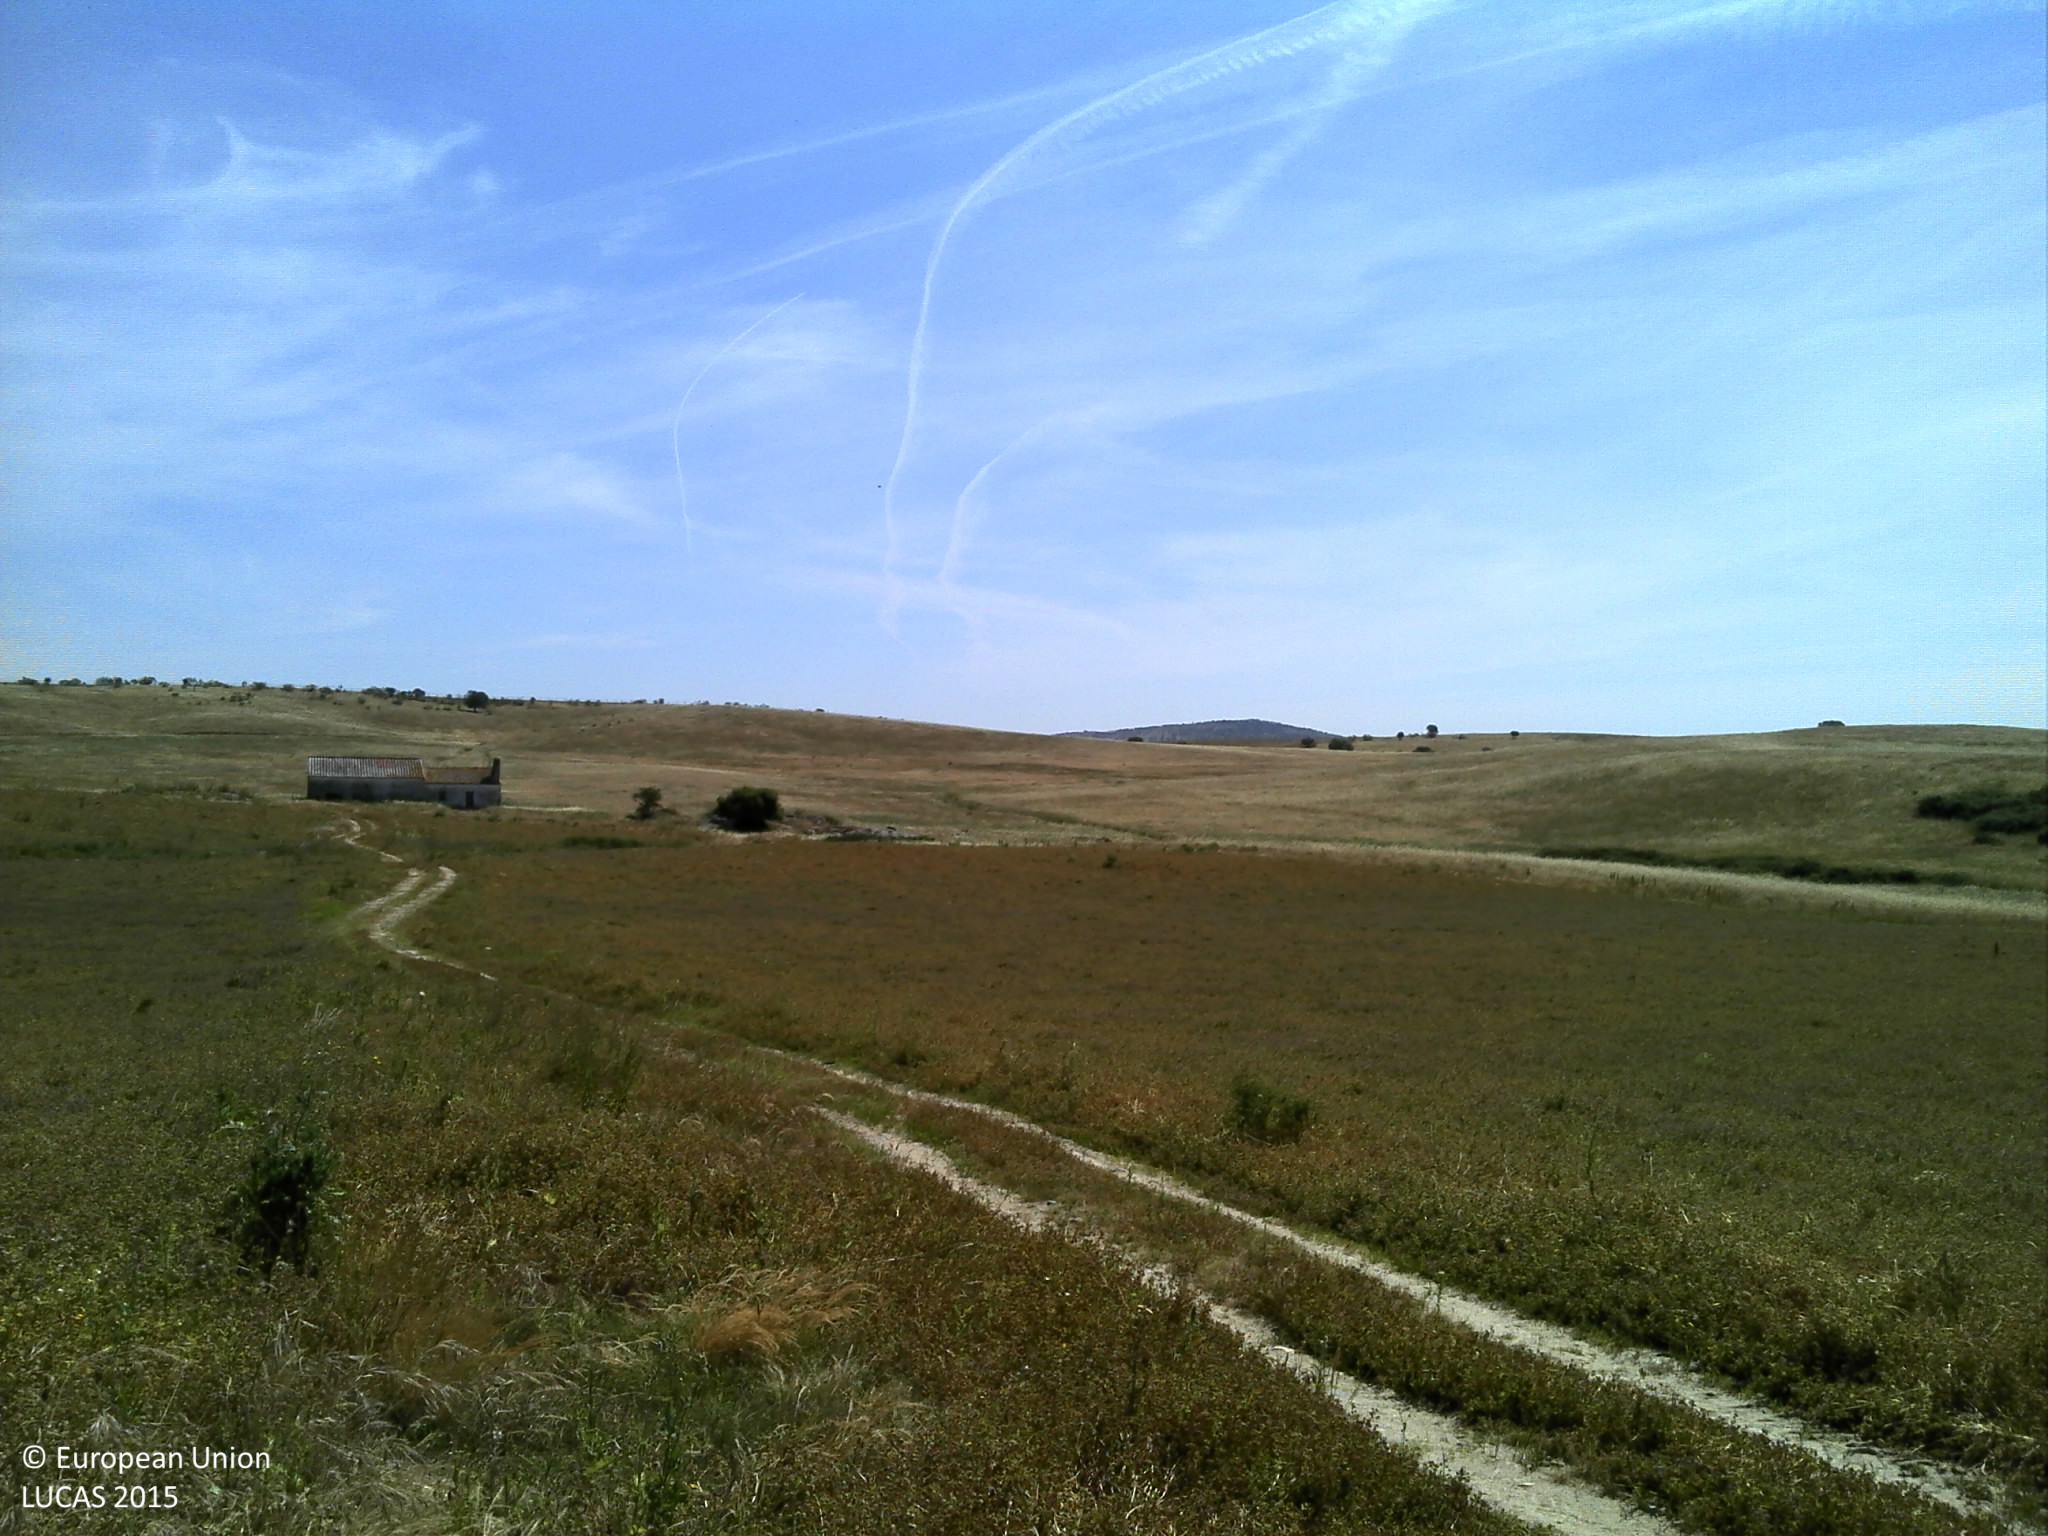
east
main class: Cropland
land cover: Clovers
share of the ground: > 75 %
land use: Agriculture (excluding fallow land and kitchen gardens)
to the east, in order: Clovers; Grass margins; Ditches and canals; Grass margins; Clovers
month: May
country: PT
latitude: 39.0864
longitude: -7.6026
